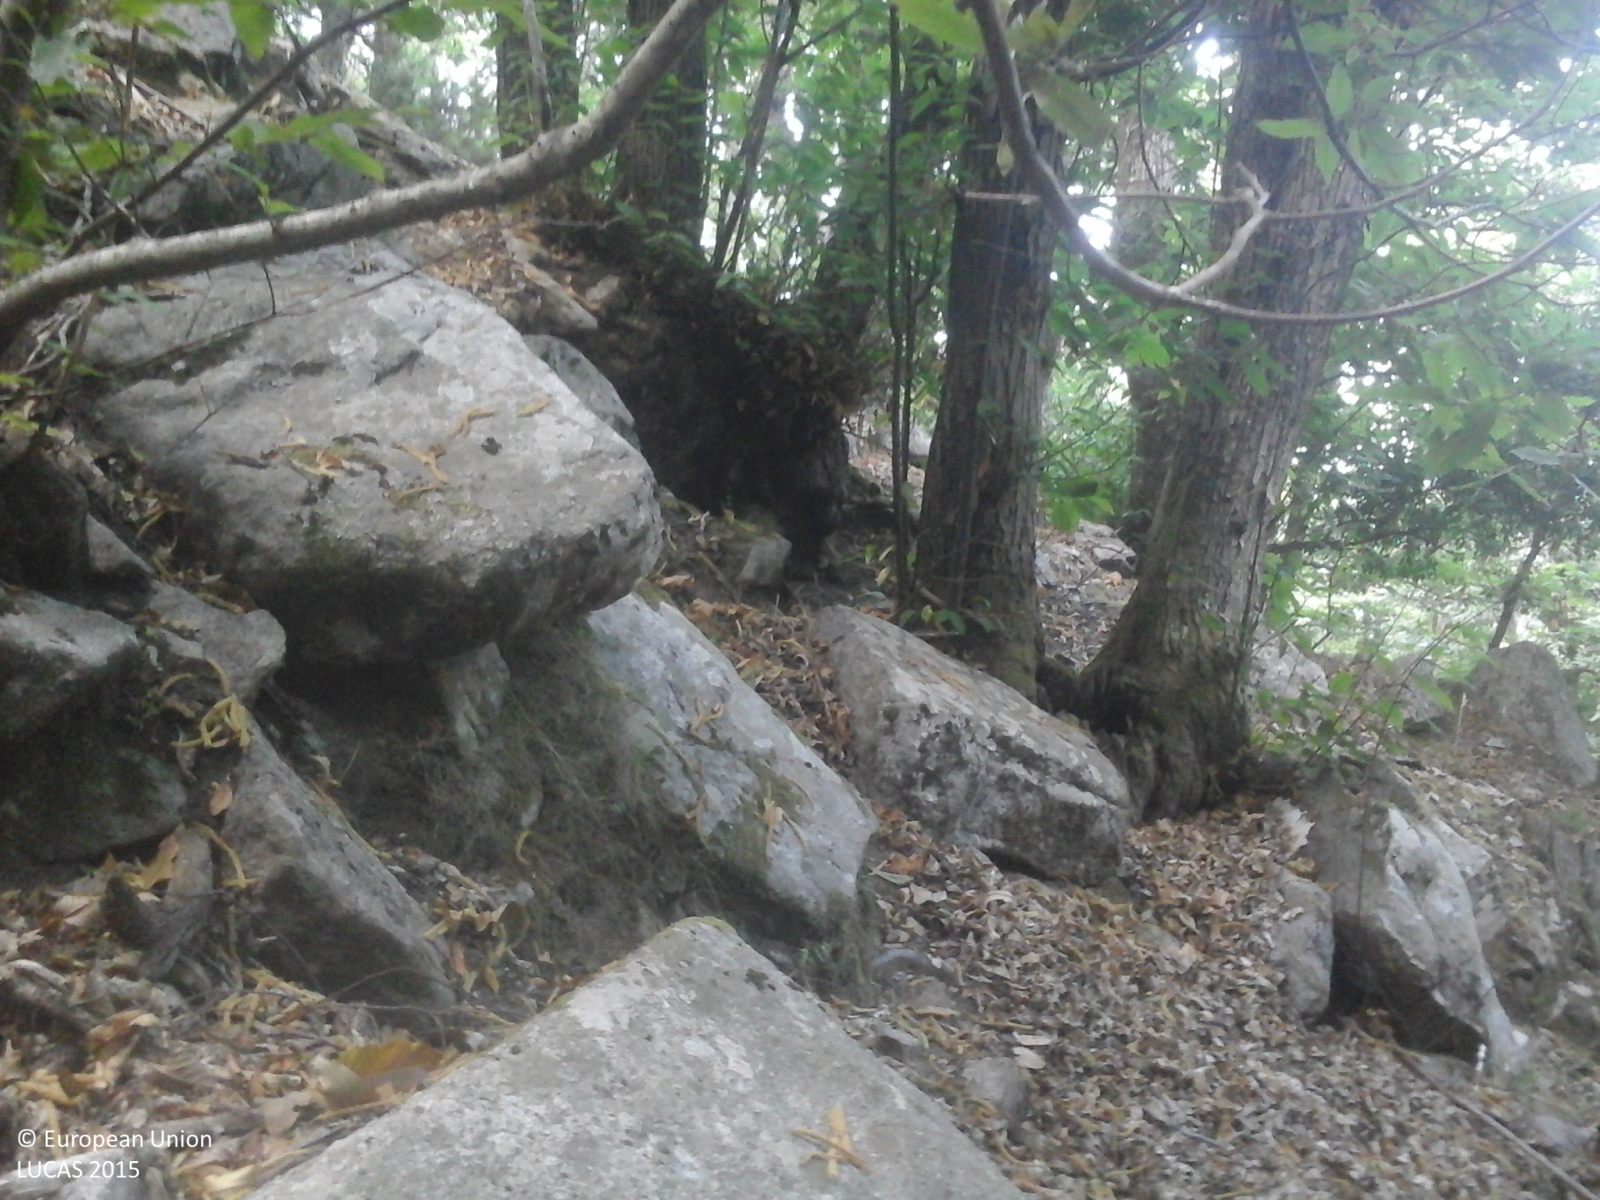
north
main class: Woodland
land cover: Broadleaved woodland
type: thermophilous deciduous forest
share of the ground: > 75 %
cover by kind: broadleaved forest trees 100 %
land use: Forestry
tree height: > 5 m
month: July
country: IT
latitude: 42.7803
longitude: 10.1827
